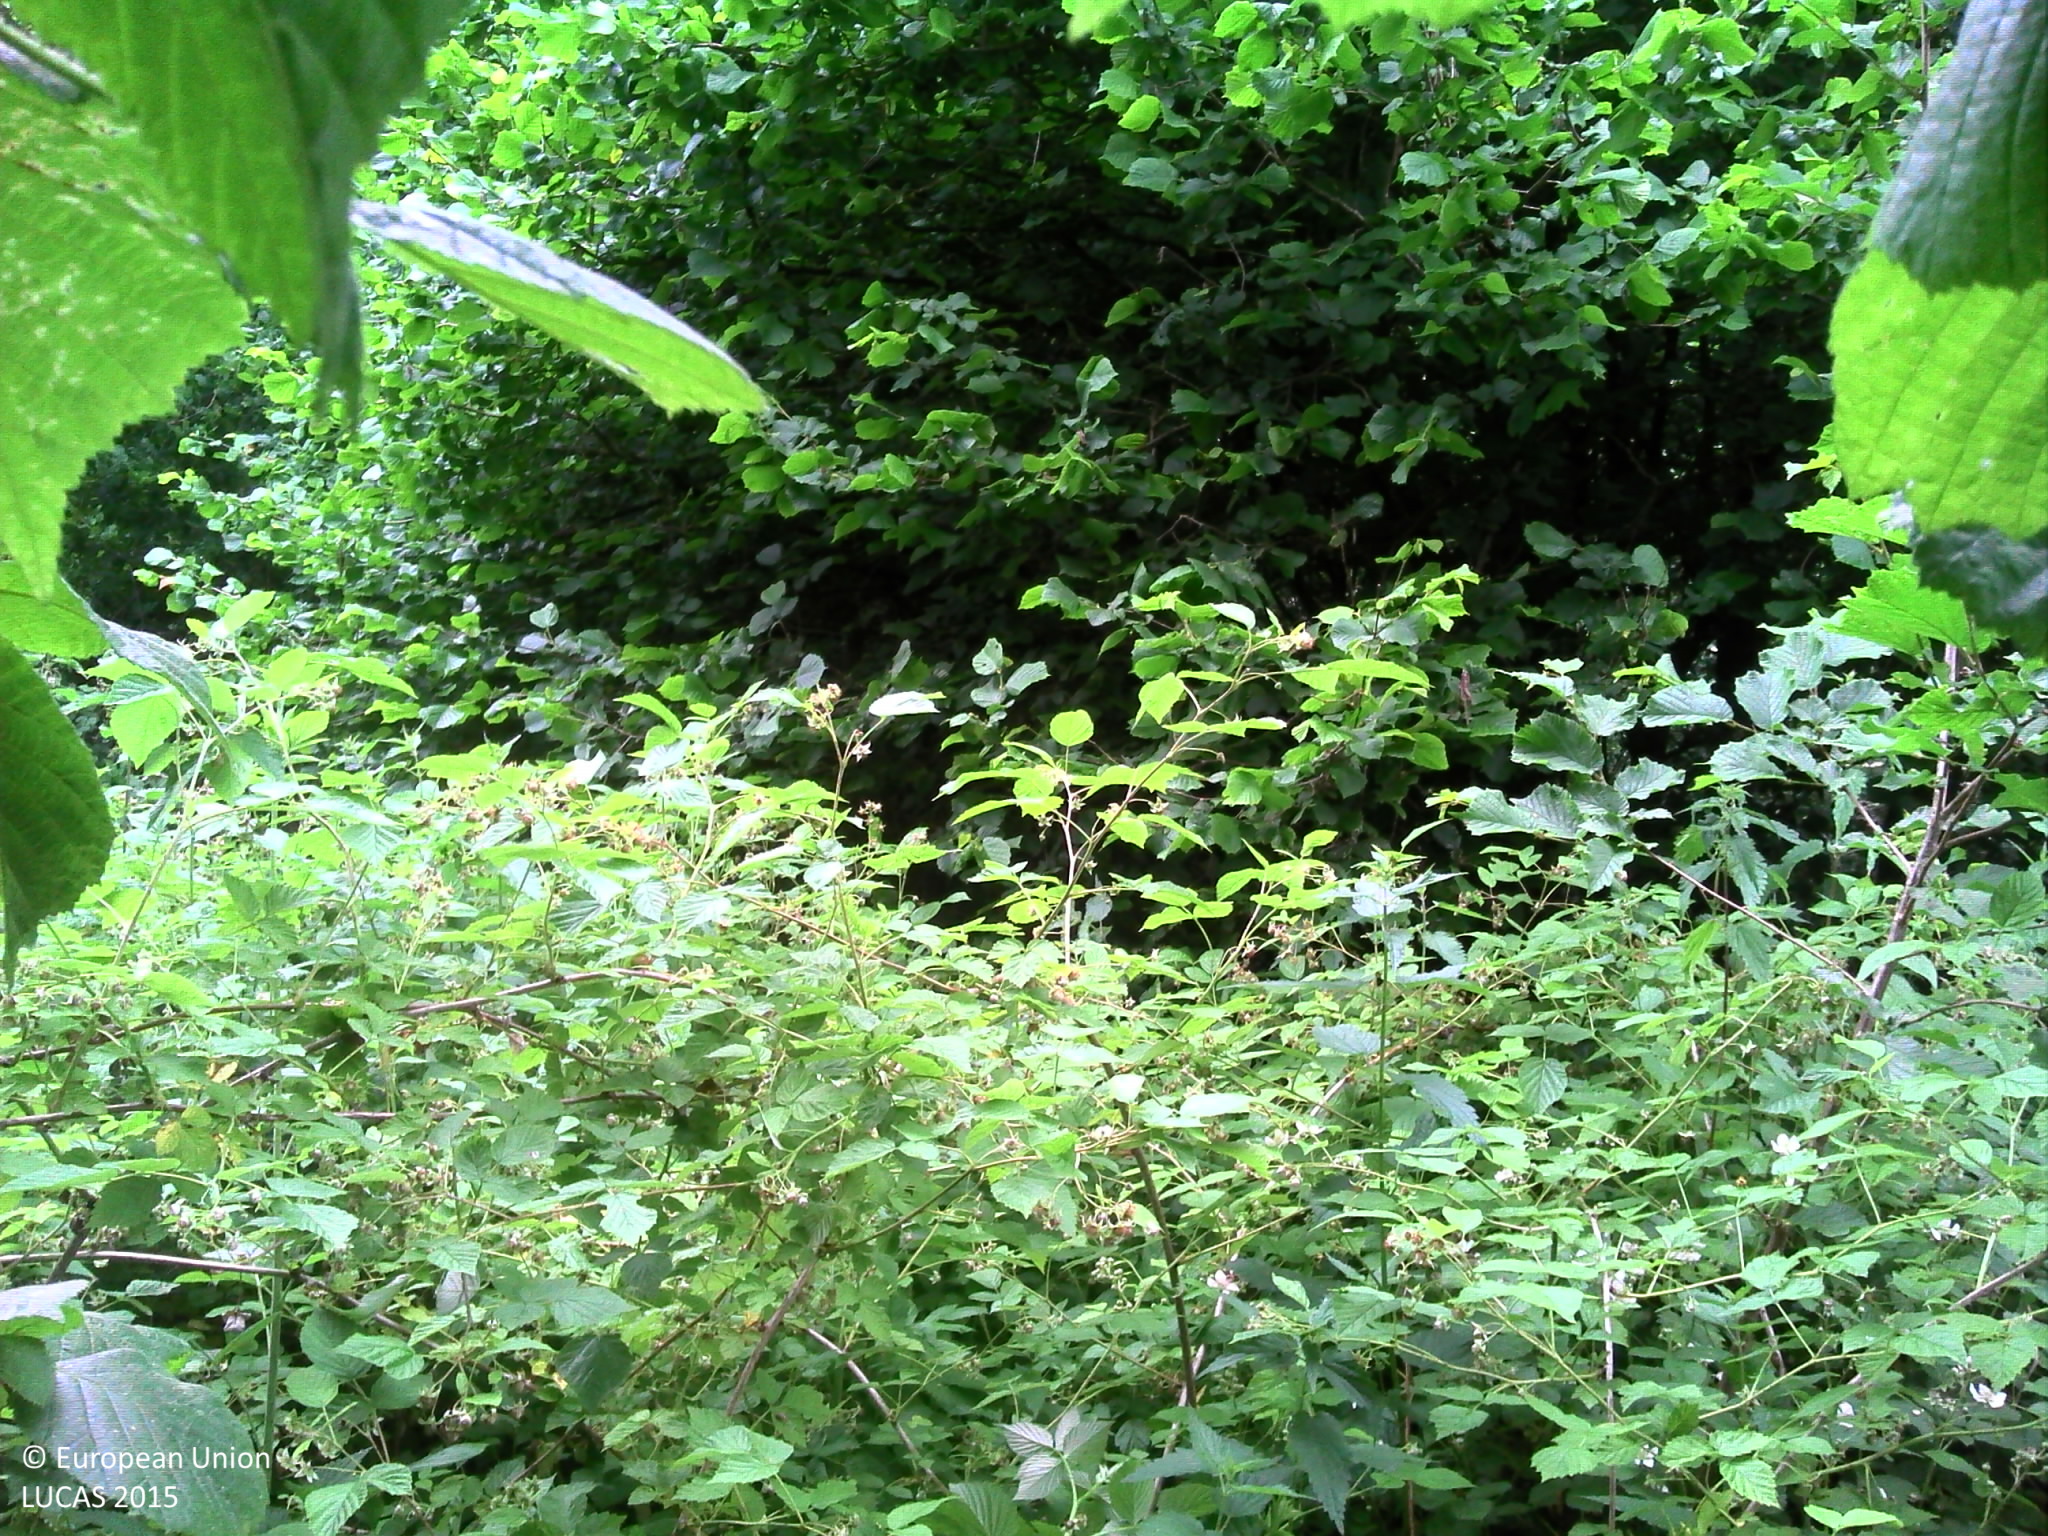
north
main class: Woodland
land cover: Broadleaved woodland
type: mesophytic deciduous forest
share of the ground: > 75 %
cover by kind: broadleaved forest trees 60 %, herbaceous plants 25 %, shrubs 15 %
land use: Forestry
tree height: > 5 m
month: June
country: BE
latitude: 50.3650
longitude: 5.4855
